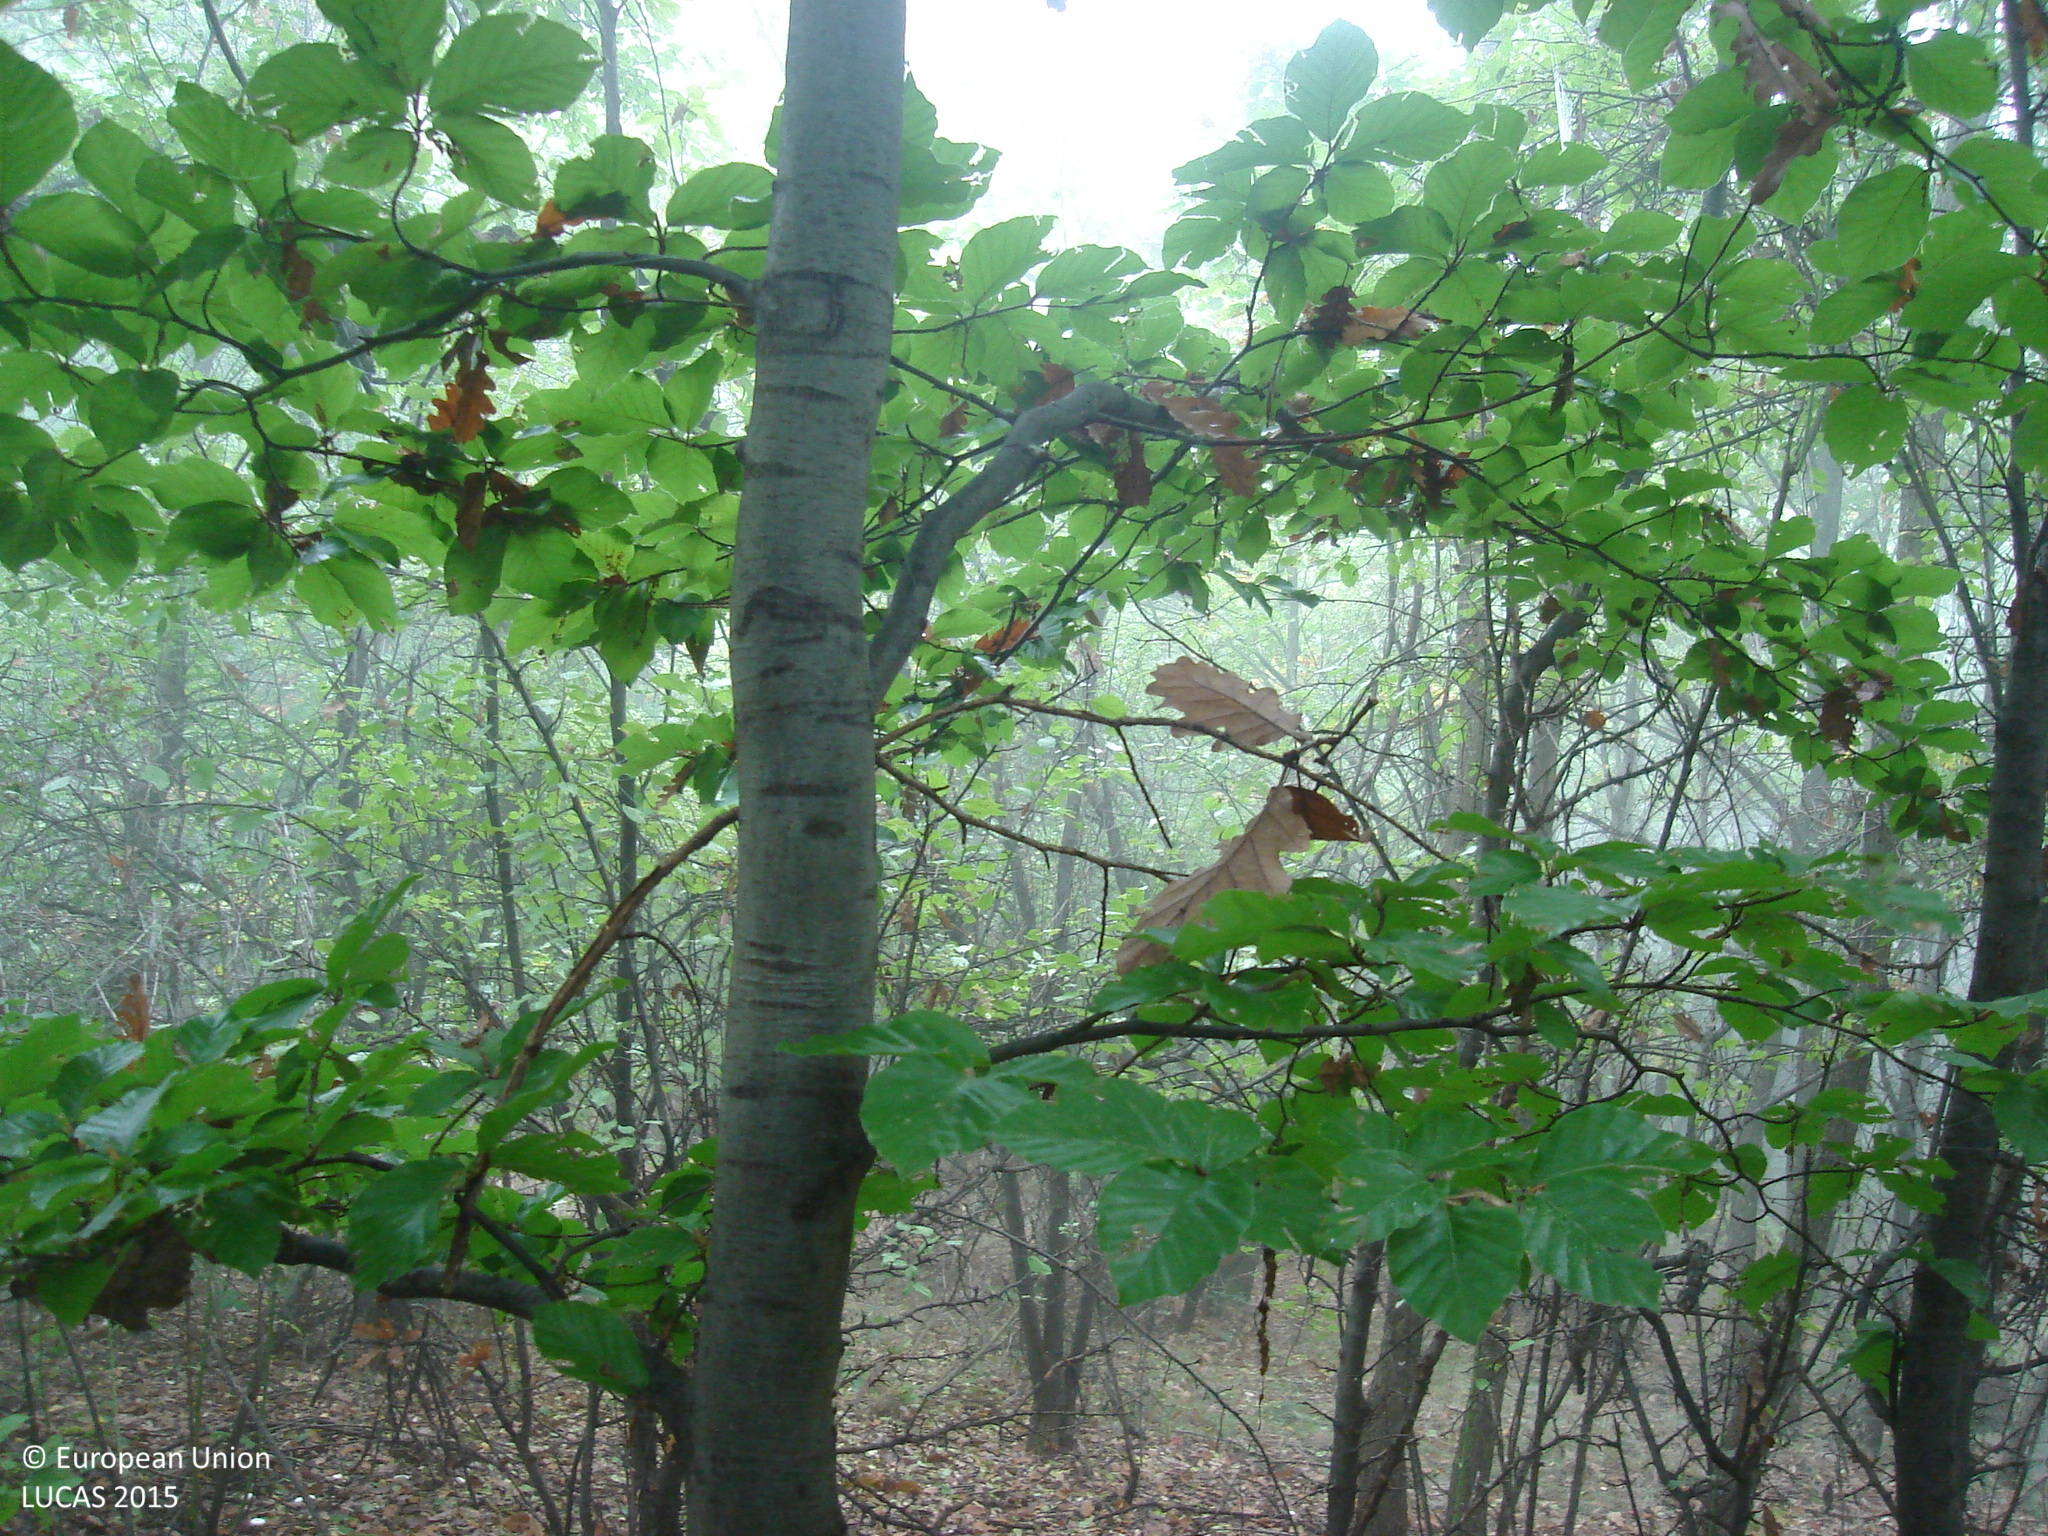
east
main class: Woodland
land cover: Broadleaved woodland
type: mesophytic deciduous forest
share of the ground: > 75 %
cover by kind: broadleaved forest trees 80 %, unconsolidated bare surface 20 %
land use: Forestry
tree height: > 5 m
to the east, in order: Broadleaved woodland; Tracks; Broadleaved woodland; Grassland with sparse tree/shrub cover; Broadleaved woodland; Tracks; Grassland with sparse tree/shrub cover; Electric lines; Grassland with sparse tree/shrub cover
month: October
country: BG
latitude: 42.4777
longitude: 23.8957
